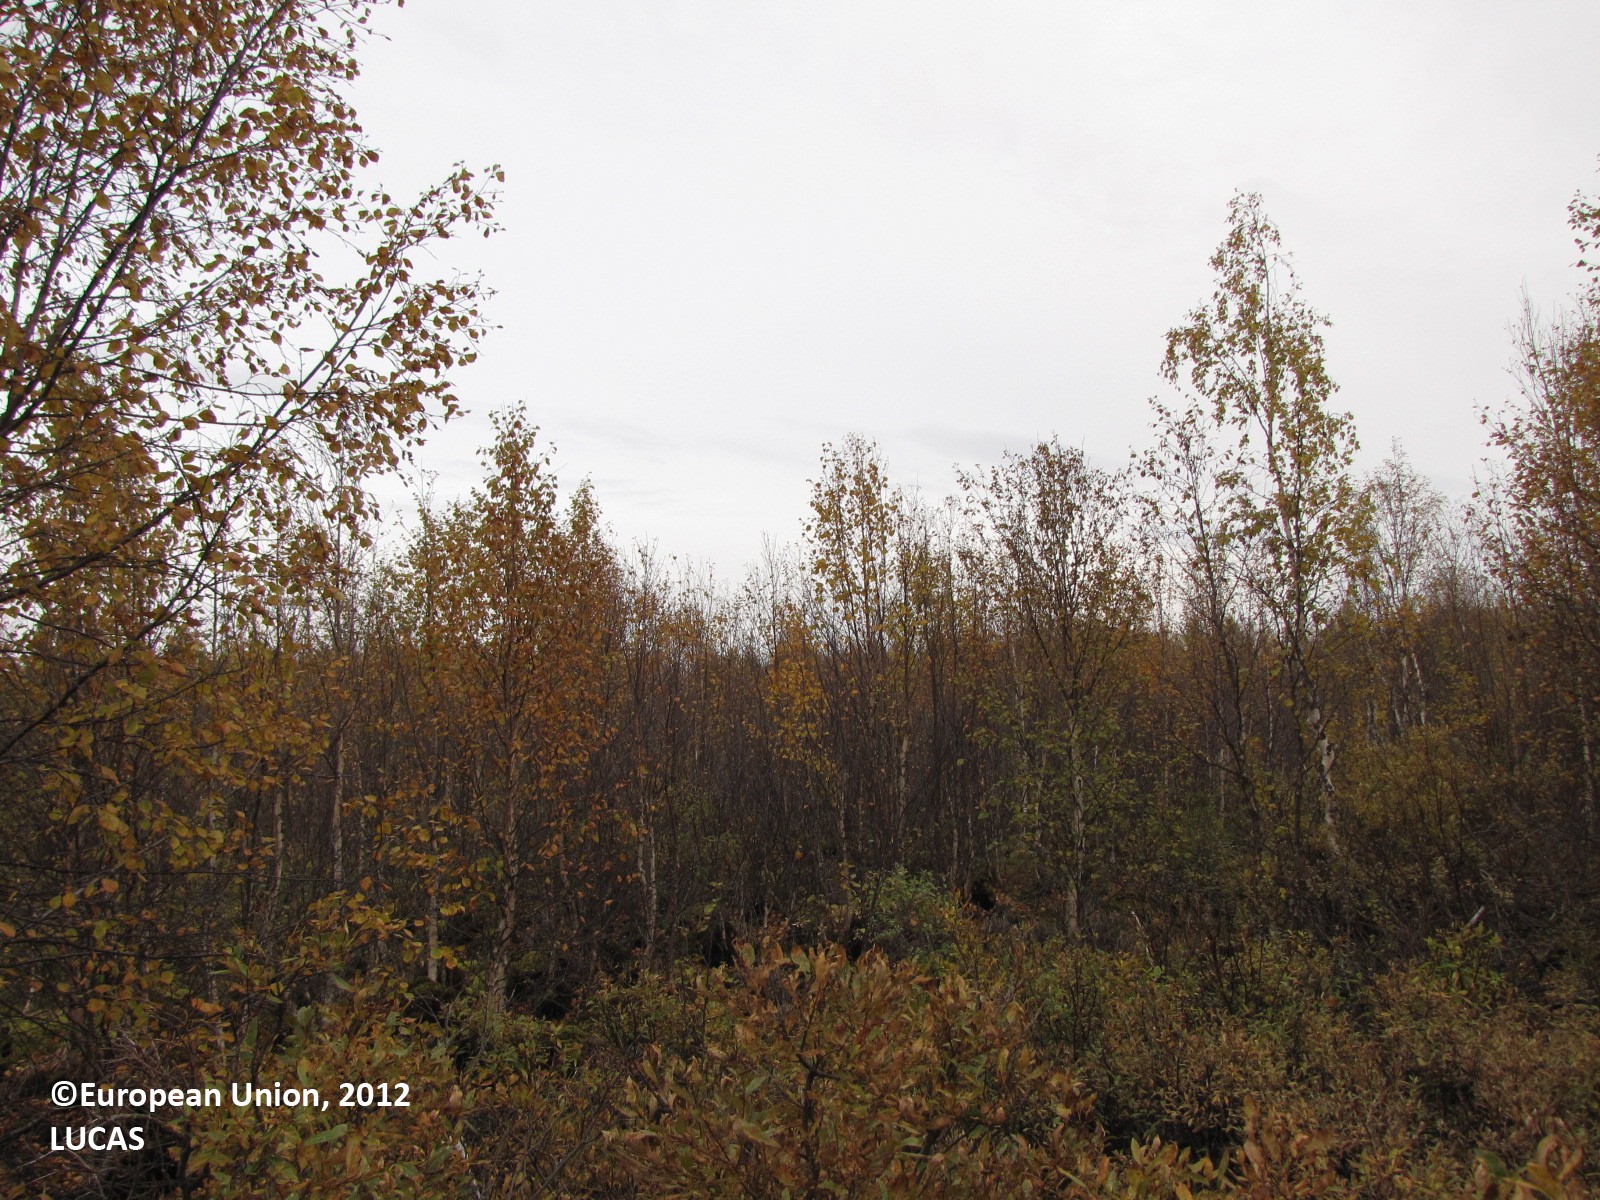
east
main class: Woodland
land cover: Broadleaved woodland
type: boreal forest
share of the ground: 25 - 50 %
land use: Forestry
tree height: > 5 m
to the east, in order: Broadleaved woodland; Ditches and canals; Broadleaved woodland; Ditches and canals; Pine dominated mixed woodland; Ditches and canals; Pine dominated mixed woodland; Pine dominated coniferous woodland
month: September
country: FI
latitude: 67.3857
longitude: 23.7944
